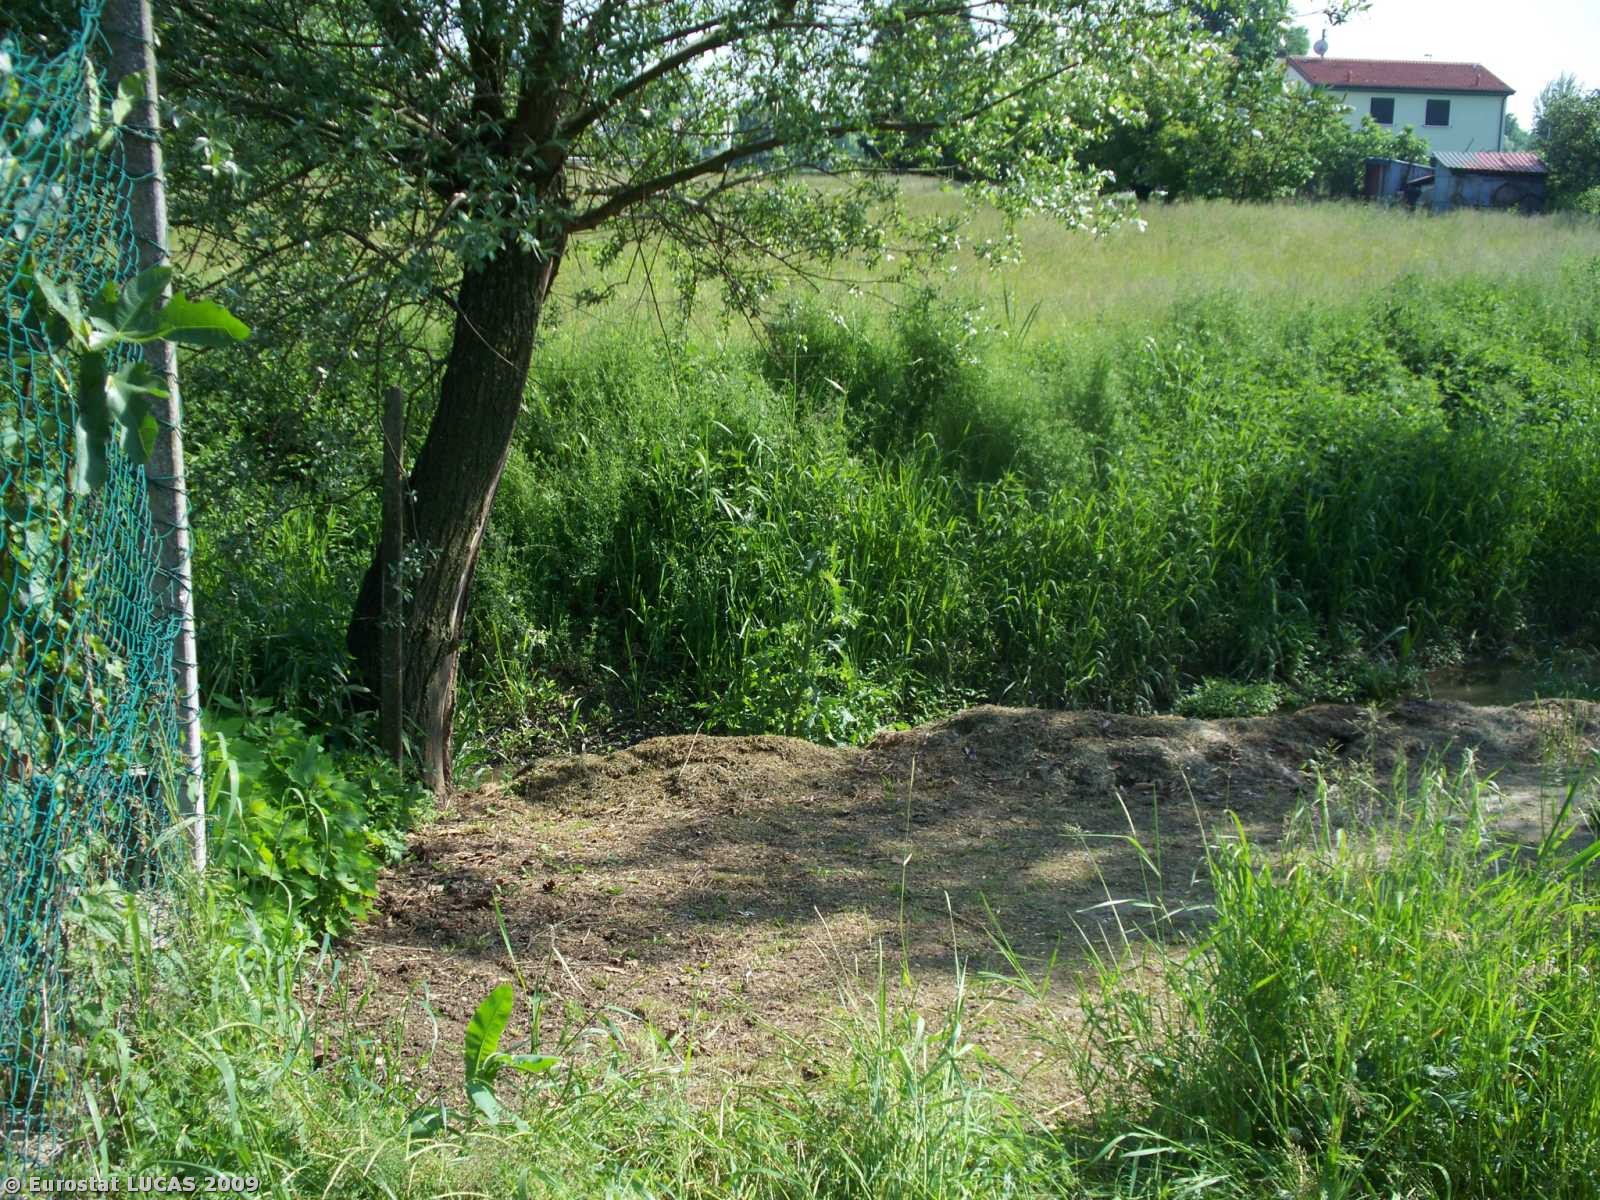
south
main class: Cropland
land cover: Vineyards
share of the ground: < 10 %
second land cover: Grassland with sparse tree/shrub cover
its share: > 75 %
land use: Agriculture (excluding fallow land and kitchen gardens)
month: May
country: IT
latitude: 45.5384
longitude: 12.0586
